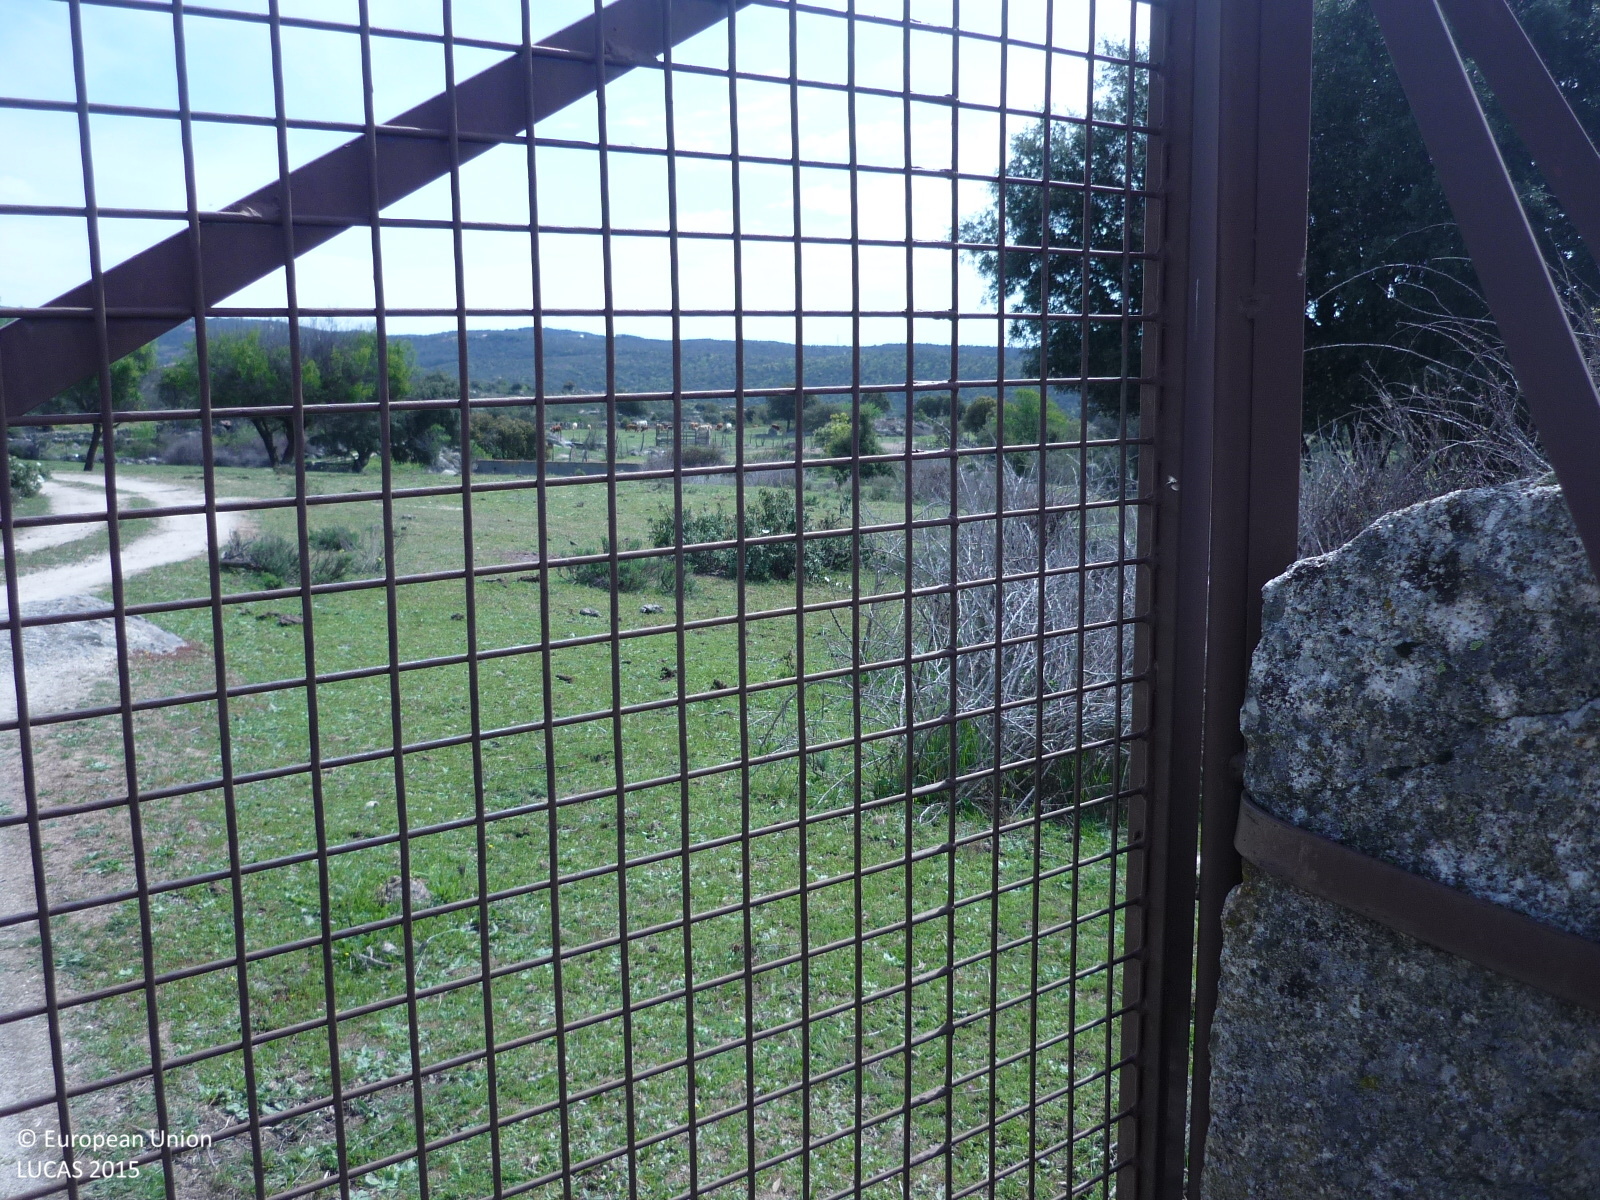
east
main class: Grassland
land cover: Grassland with sparse tree/shrub cover
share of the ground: > 75 %
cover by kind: herbaceous plants 85 %, shrubs 10 %, broadleaved forest trees 5 %
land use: Agriculture (excluding fallow land and kitchen gardens)
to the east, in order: Grassland with sparse tree/shrub cover; Dry stone walls; Tracks; Shrubland with sparse tree cover; Tracks; Shrubland with sparse tree cover; Rocks and stones; Dry stone walls; Grassland with sparse tree/shrub cover; Rock outcrops; Shrubland without tree cover
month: April
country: ES
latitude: 40.8569
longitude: -3.5770
